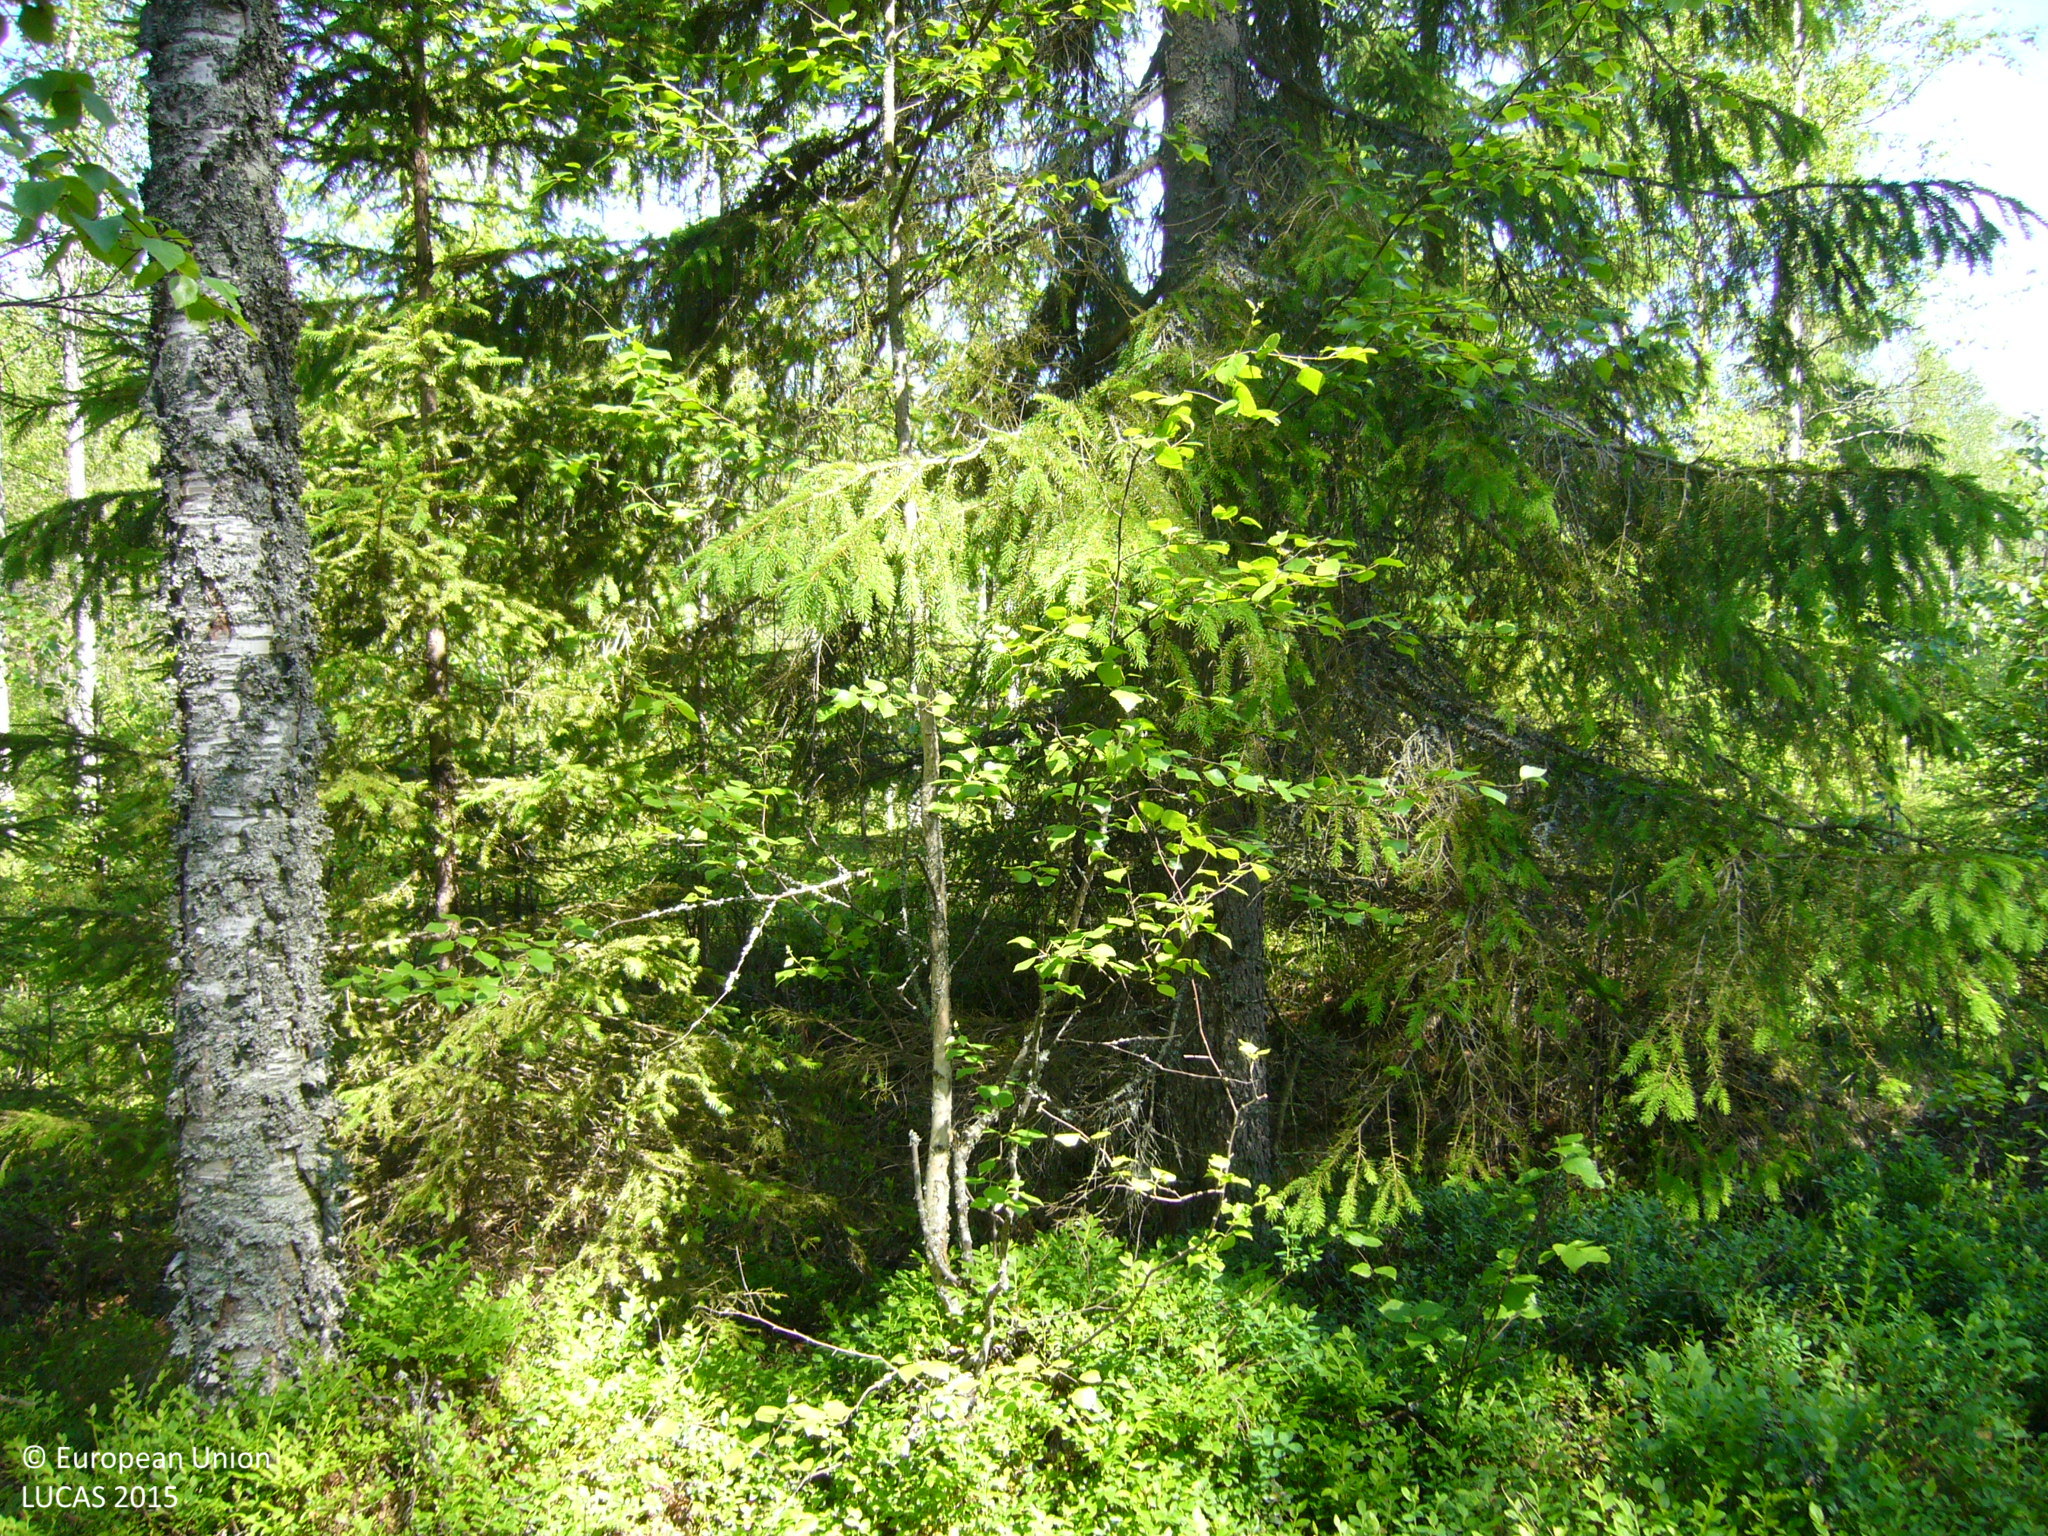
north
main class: Woodland
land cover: Pine dominated mixed woodland
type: boreal forest
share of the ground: > 75 %
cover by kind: coniferous forest trees 60 %, broadleaved forest trees 25 %, shrubs 15 %
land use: Forestry
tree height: > 5 m
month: June
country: FI
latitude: 63.8679
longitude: 26.5877
